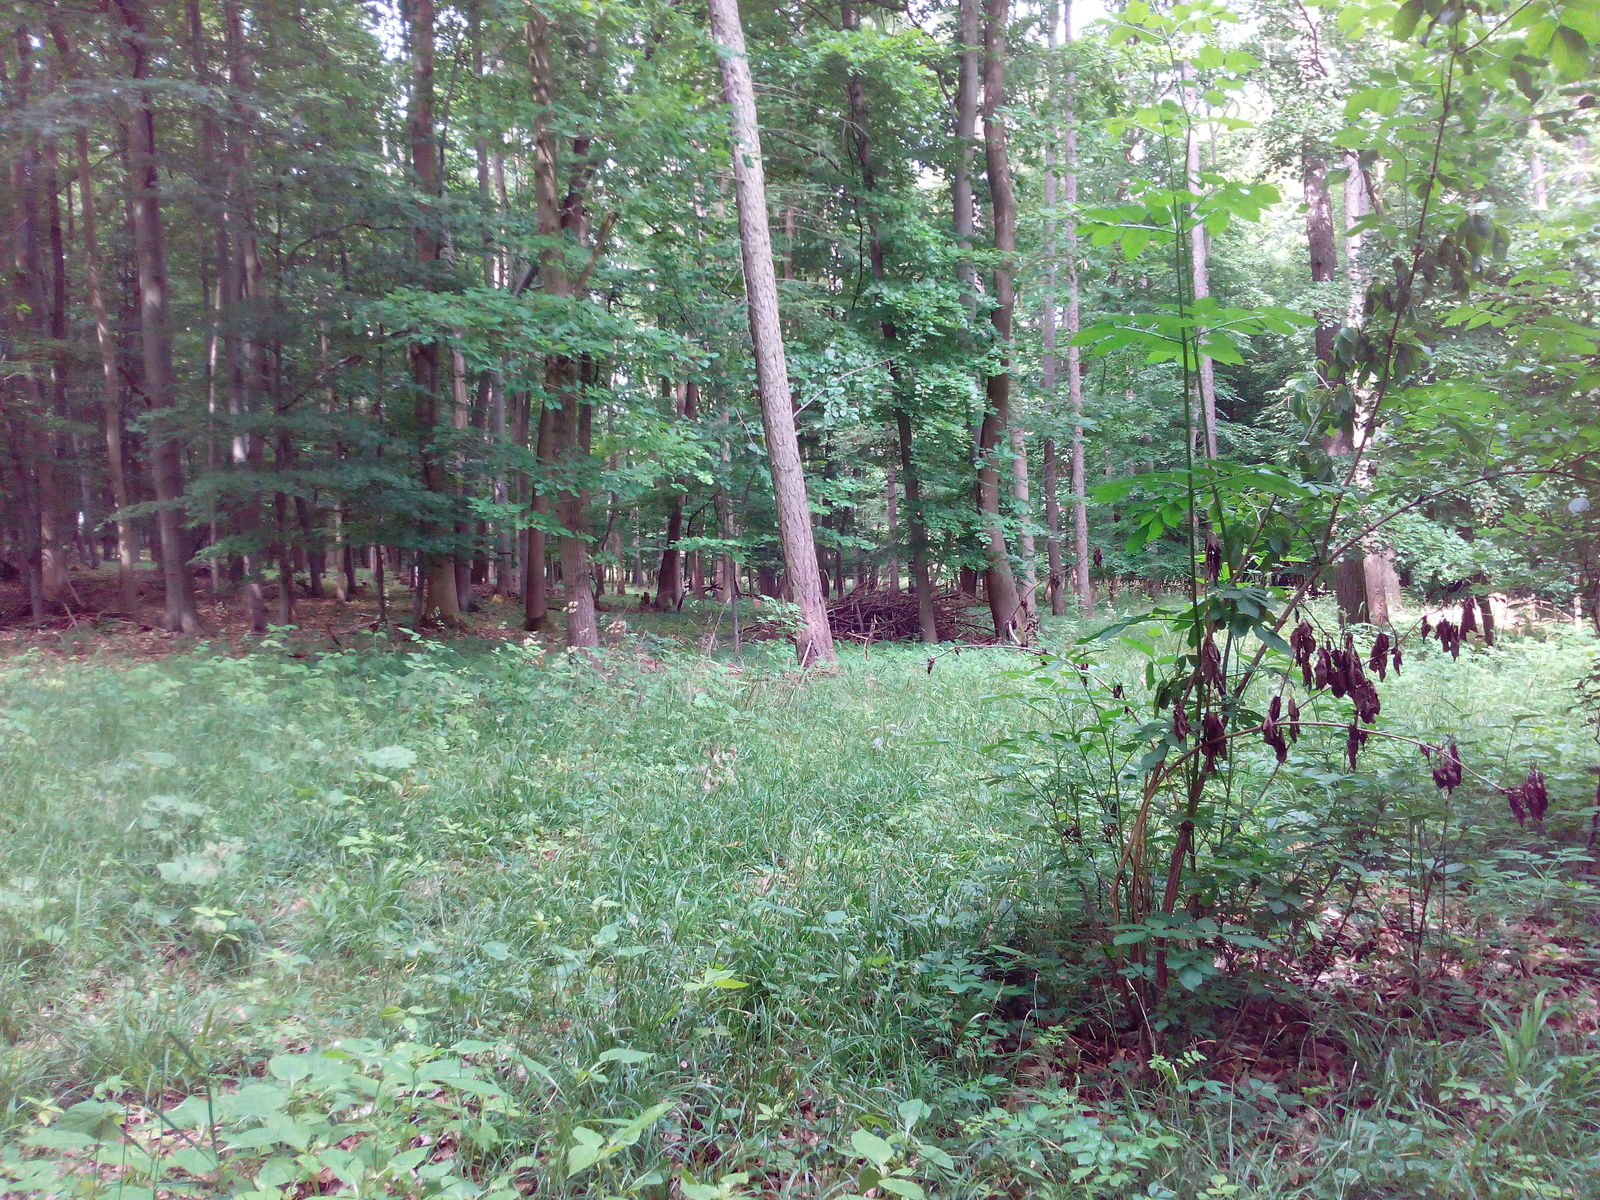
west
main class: Woodland
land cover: Broadleaved woodland
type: beech forest
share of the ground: > 75 %
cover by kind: broadleaved forest trees 90 %, herbaceous plants 10 %
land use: Forestry
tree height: > 5 m
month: June
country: DE
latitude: 51.3304
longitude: 11.0187
